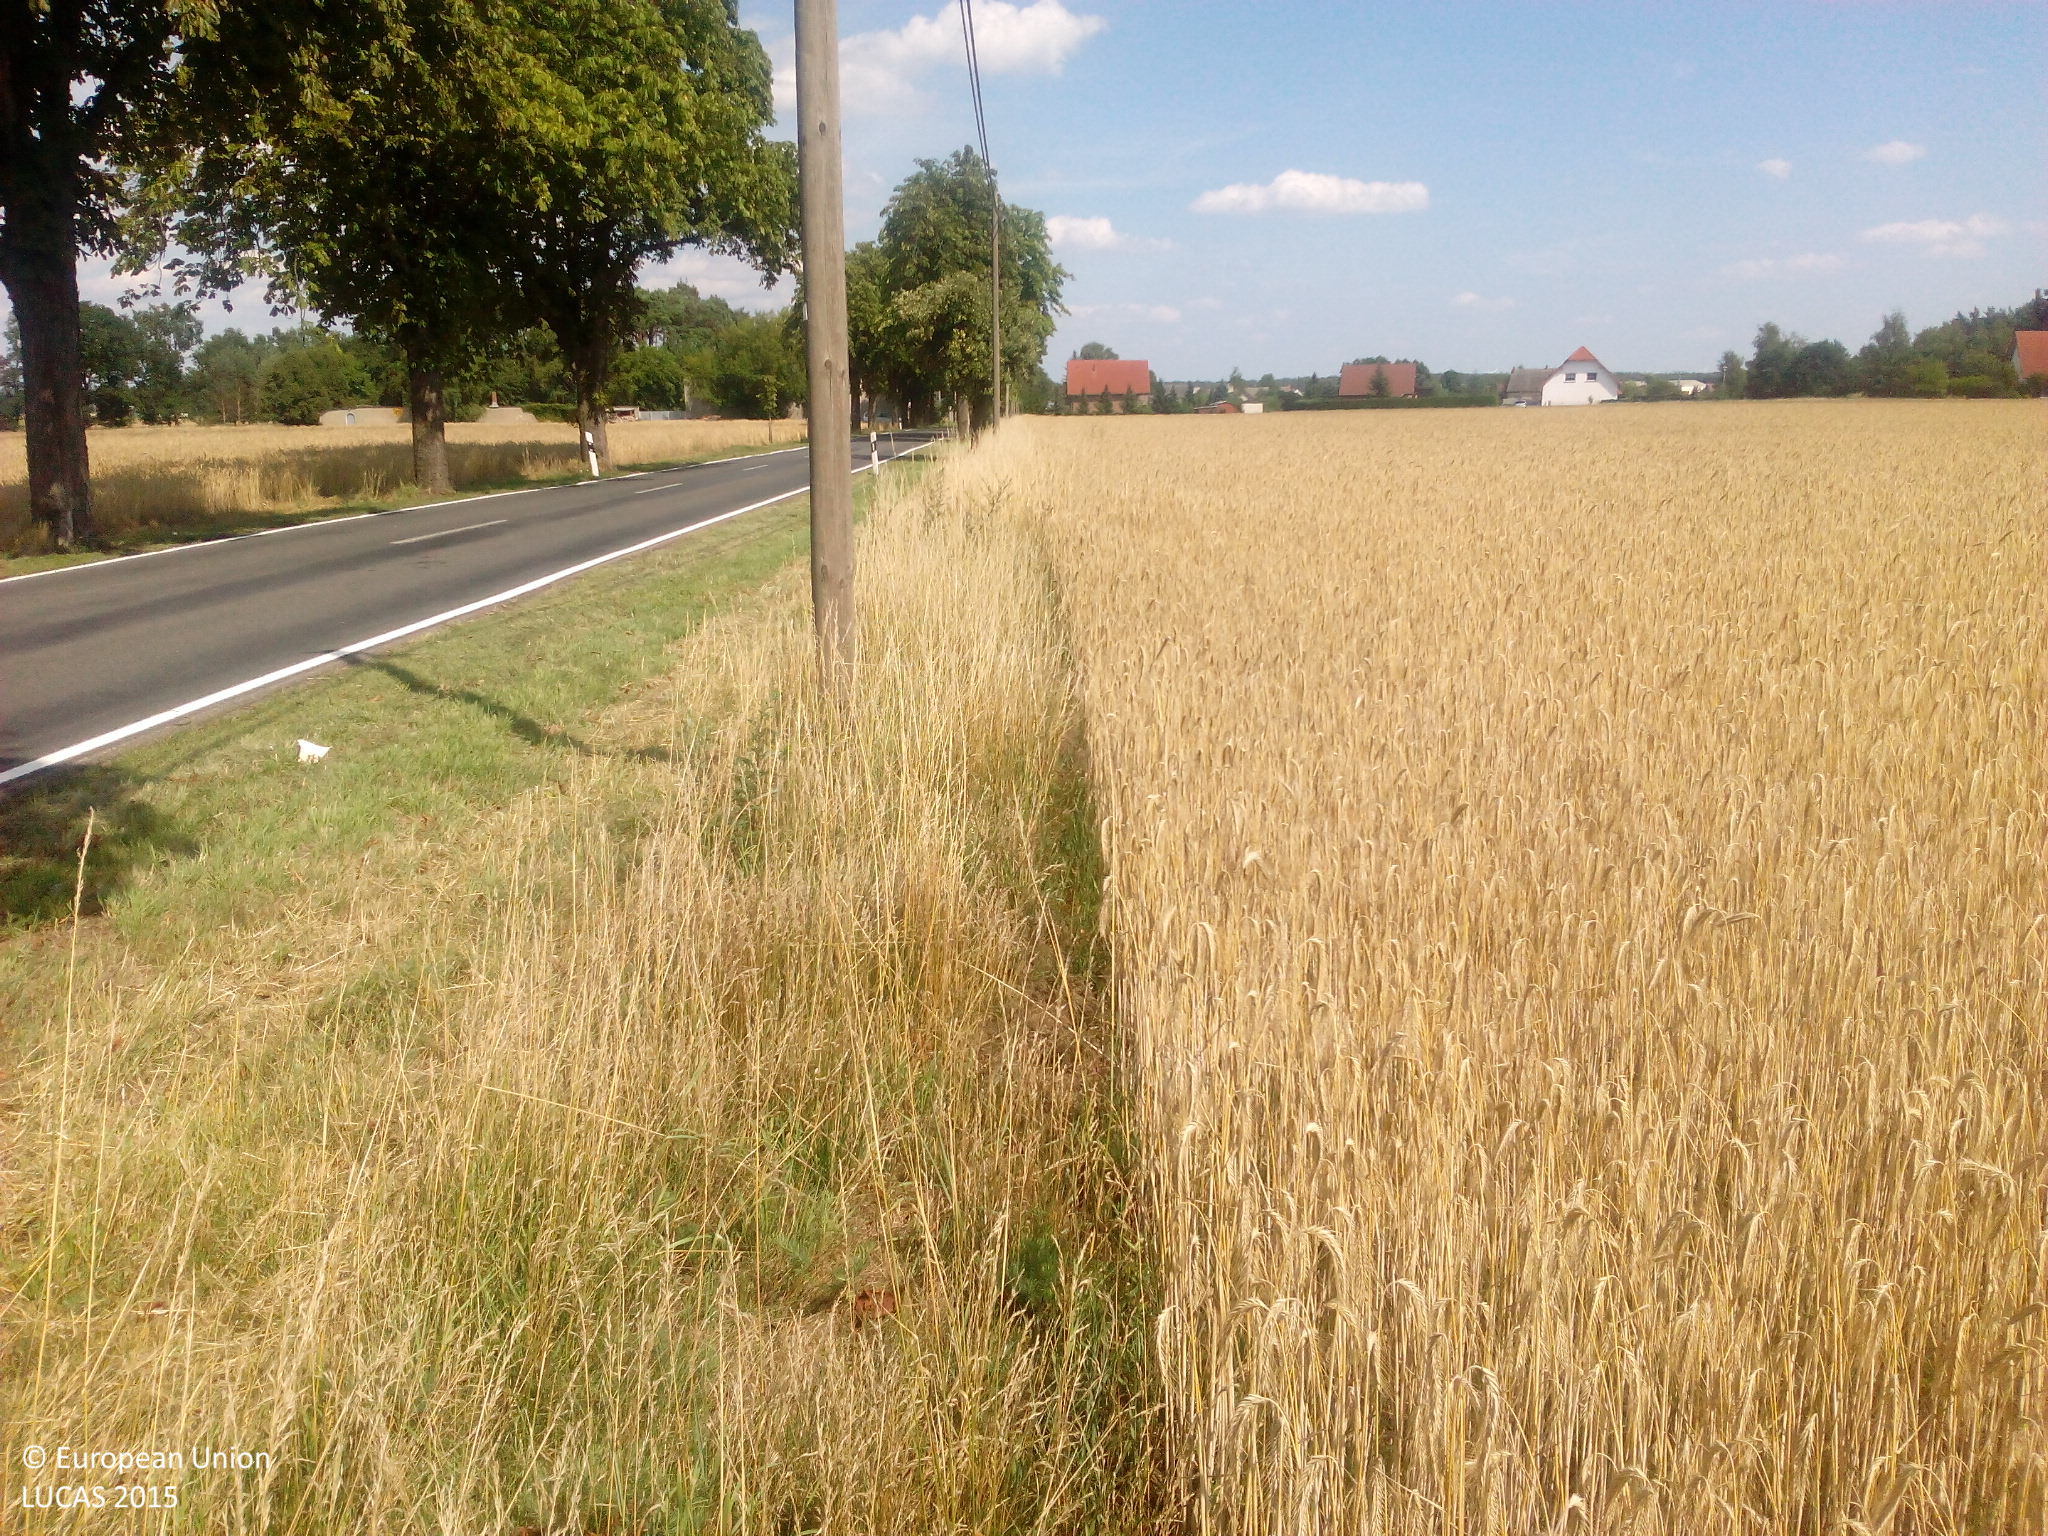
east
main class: Cropland
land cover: Rye
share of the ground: > 75 %
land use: Agriculture (excluding fallow land and kitchen gardens)
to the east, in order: Rye; Artificial constructions in urban areas; Grassland without tree/shrub cover
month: July
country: DE
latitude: 51.9234
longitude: 12.3117
